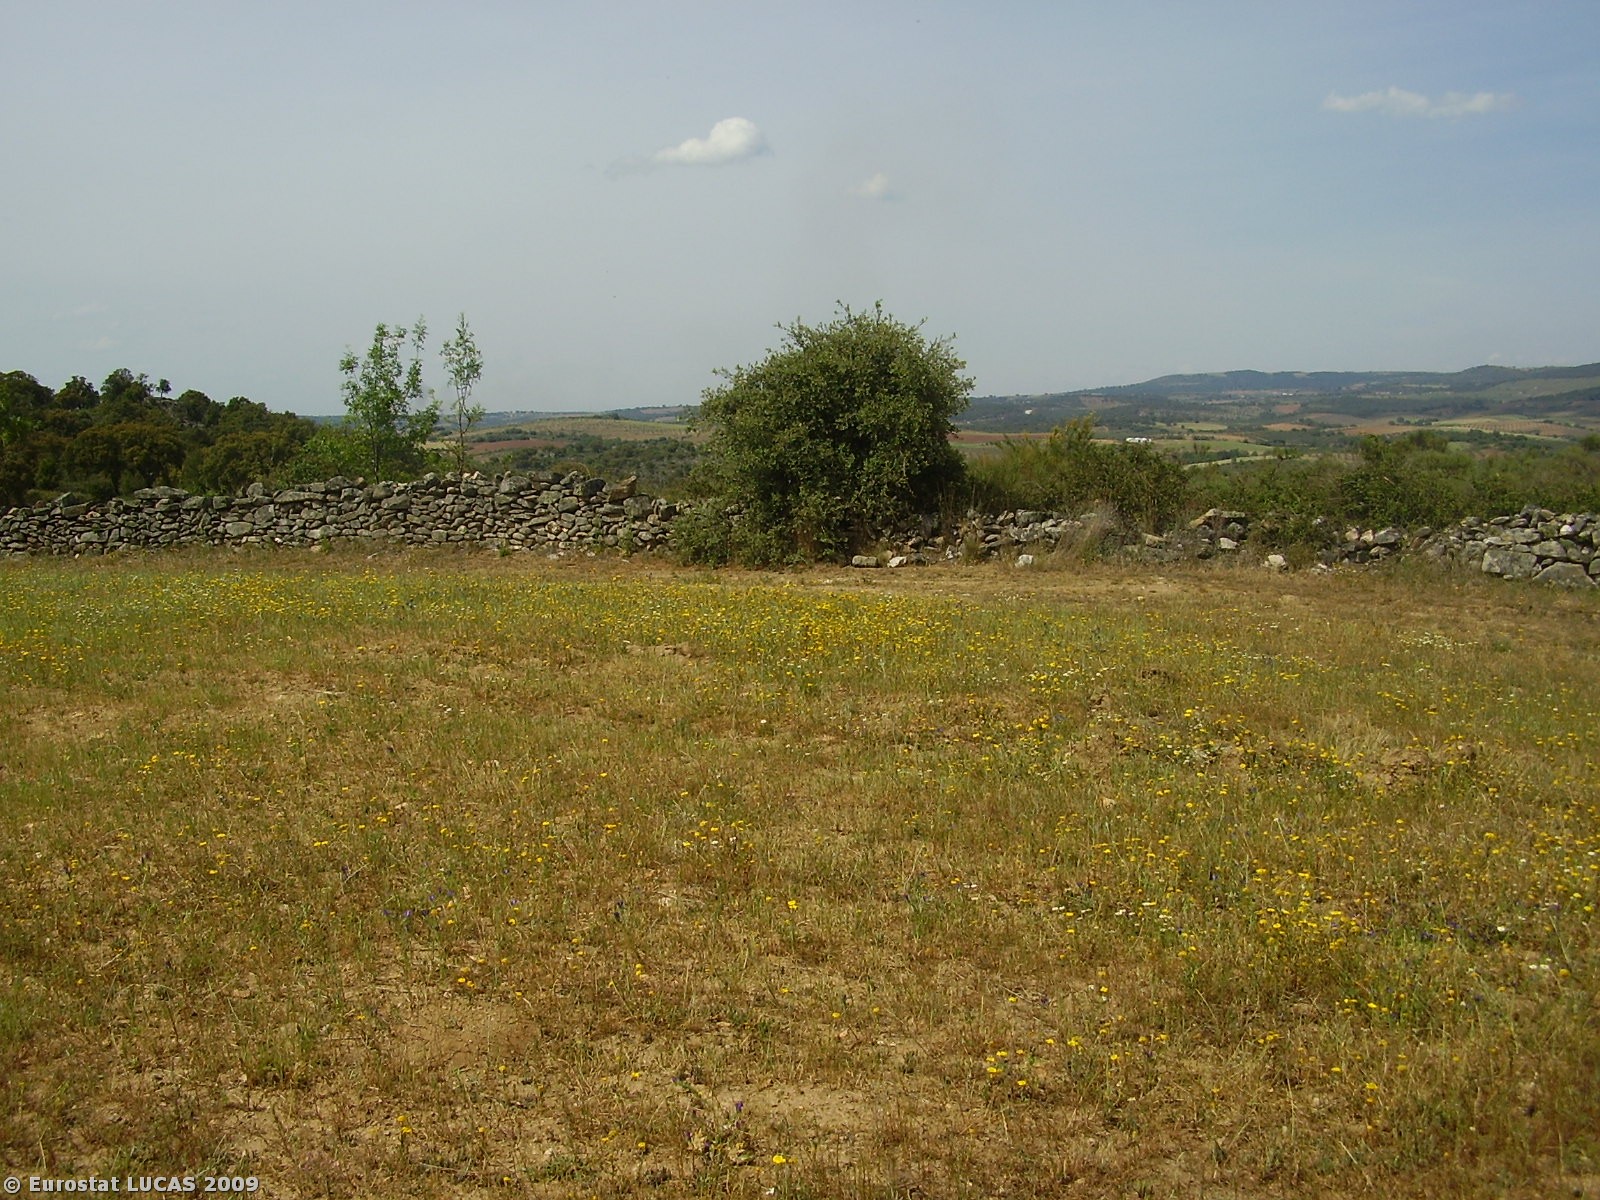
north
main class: Cropland
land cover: Mixed cereals for fodder
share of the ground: 50 - 75 %
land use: Agriculture (excluding fallow land and kitchen gardens)
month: May
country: PT
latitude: 41.5097
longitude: -7.0453
